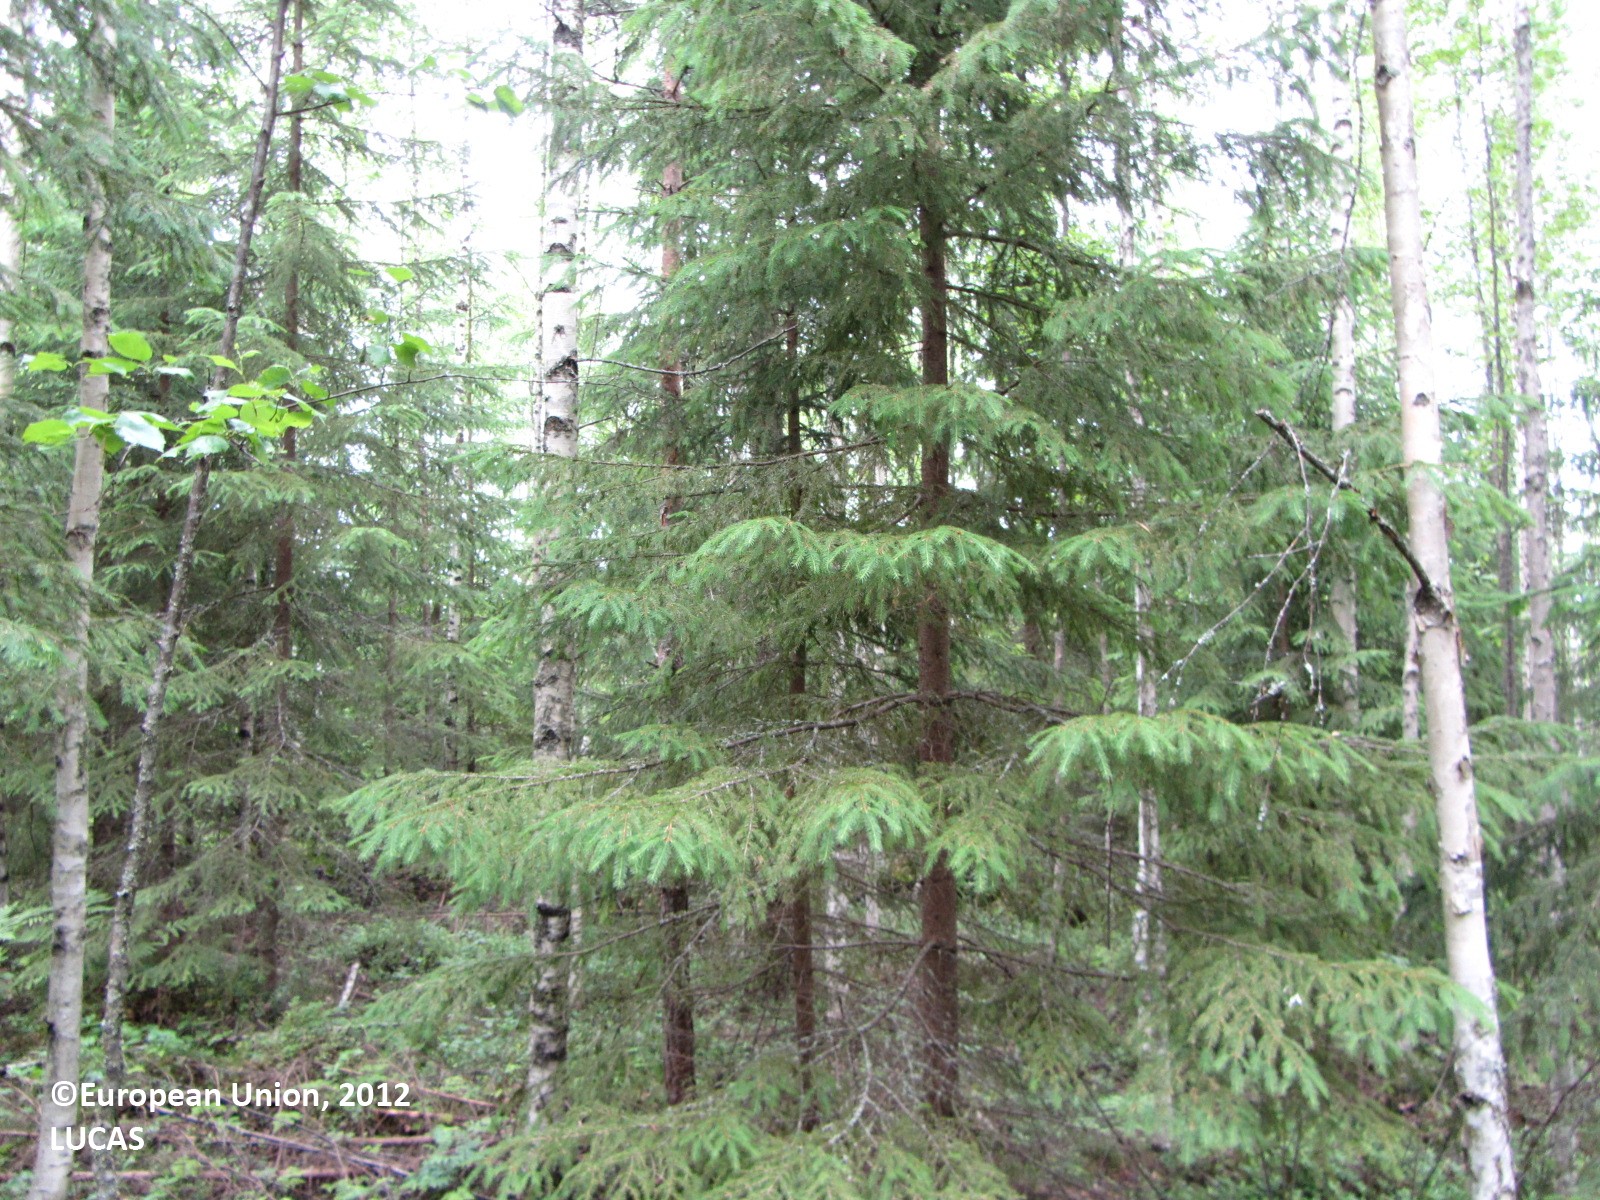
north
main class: Woodland
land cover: Spruce dominated mixed woodland
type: boreal forest
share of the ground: > 75 %
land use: Forestry
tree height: > 5 m
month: June
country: FI
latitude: 62.6465
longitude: 25.5424
